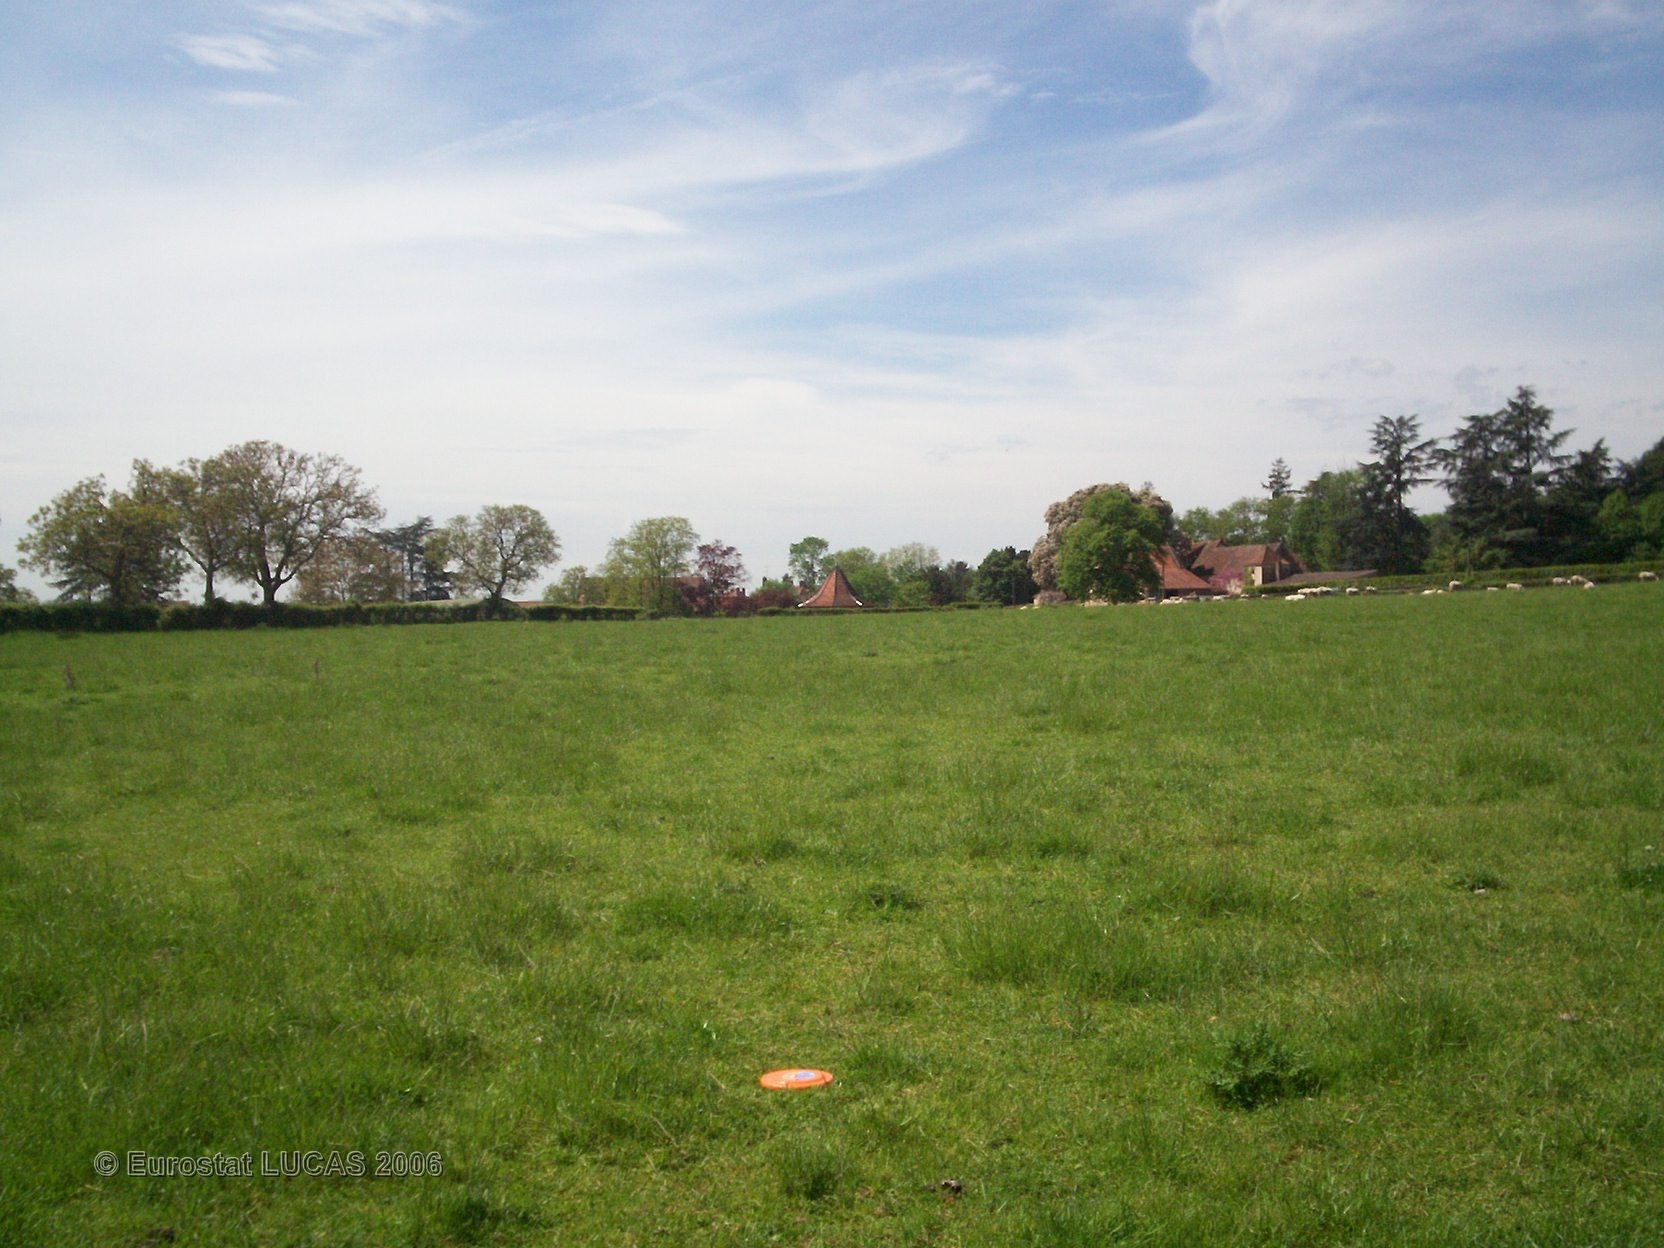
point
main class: Grassland
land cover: Grassland without tree/shrub cover
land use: Agriculture (excluding fallow land and kitchen gardens)
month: May
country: FR
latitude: 46.5829
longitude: 4.7424
